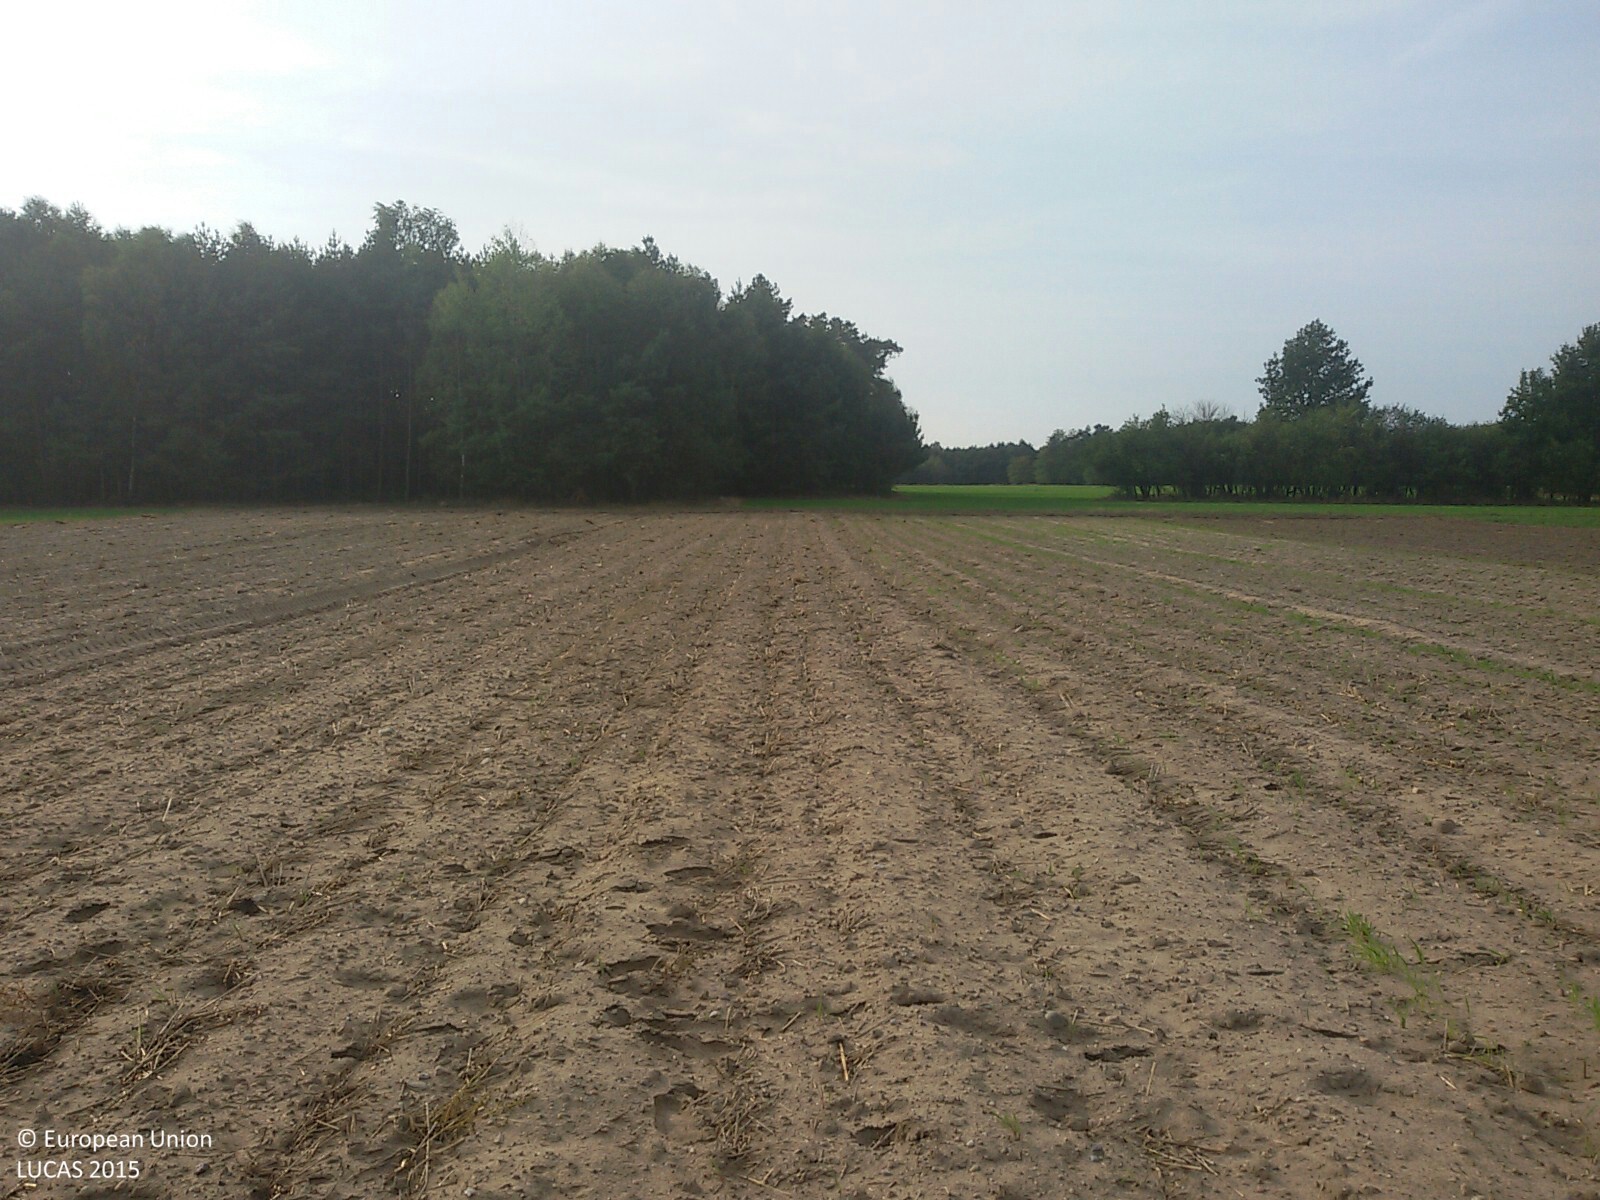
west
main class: Cropland
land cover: Rye
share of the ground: < 10 %
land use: Agriculture (excluding fallow land and kitchen gardens)
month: September
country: PL
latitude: 51.2162
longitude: 18.8266
